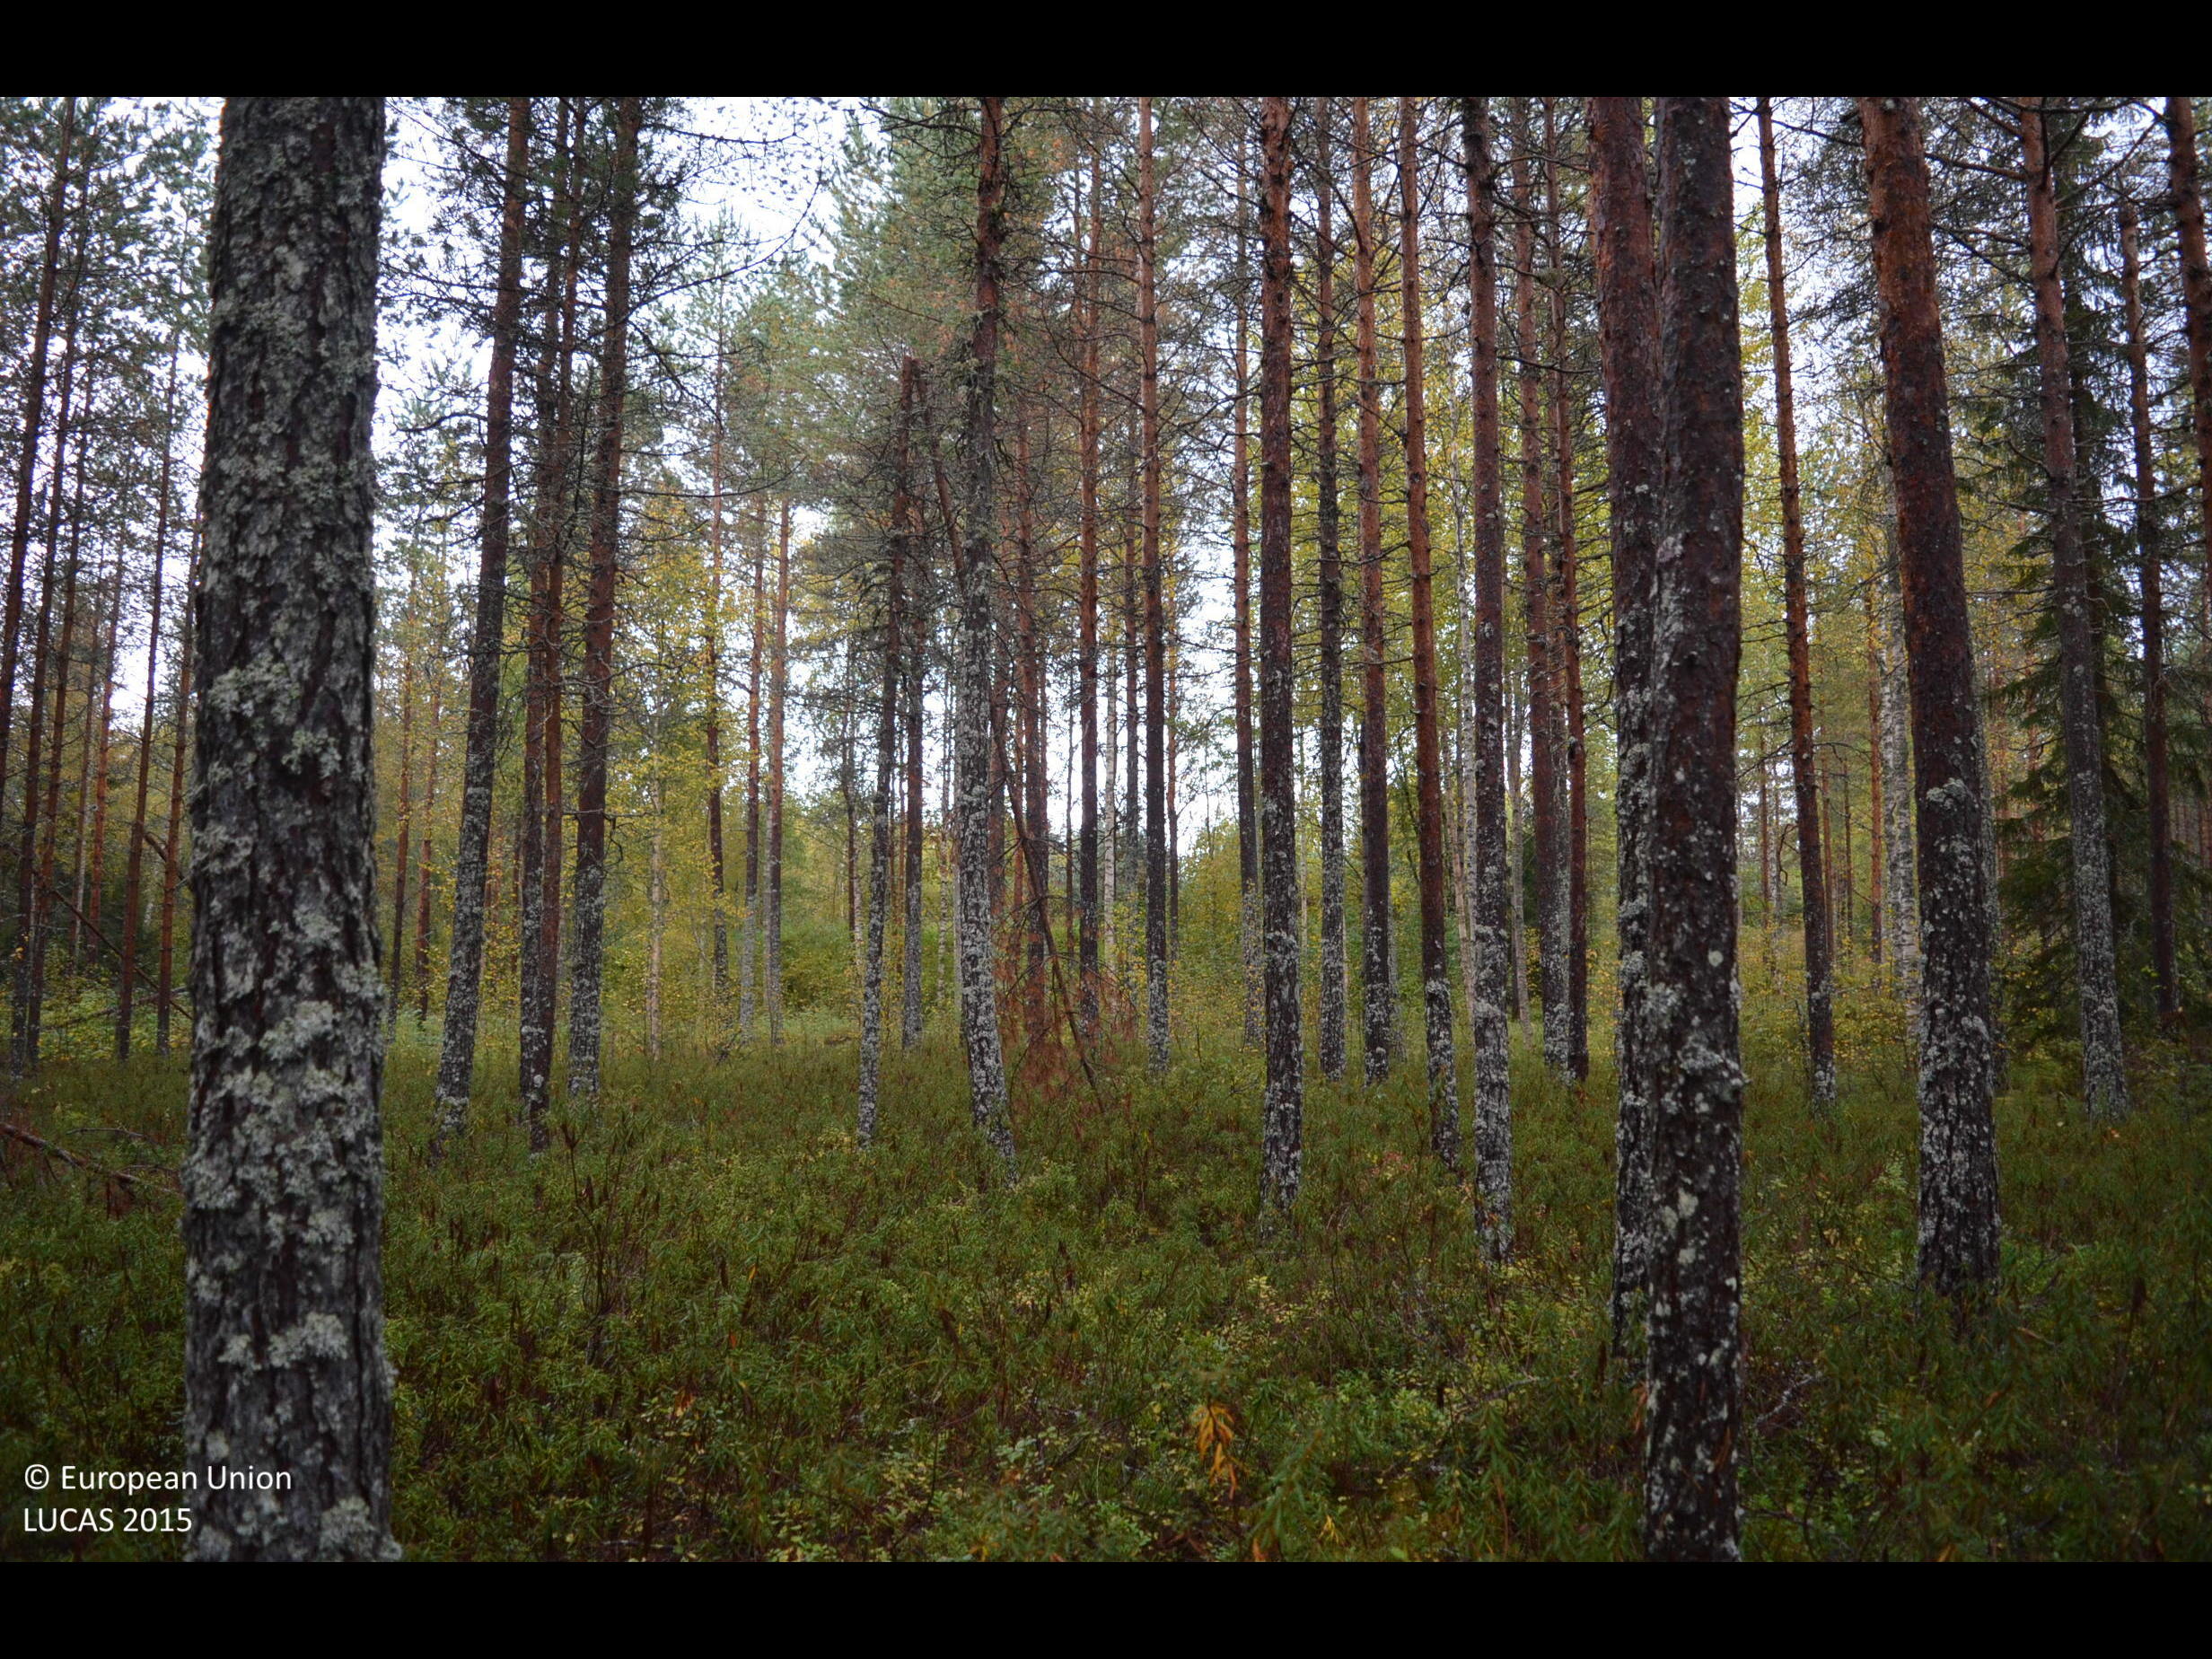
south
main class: Woodland
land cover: Pine dominated coniferous woodland
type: boreal forest
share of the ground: > 75 %
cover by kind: coniferous forest trees 65 %, shrubs 25 %, broadleaved forest trees 10 %
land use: Forestry
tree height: > 5 m
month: September
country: FI
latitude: 62.8854
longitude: 23.8602
